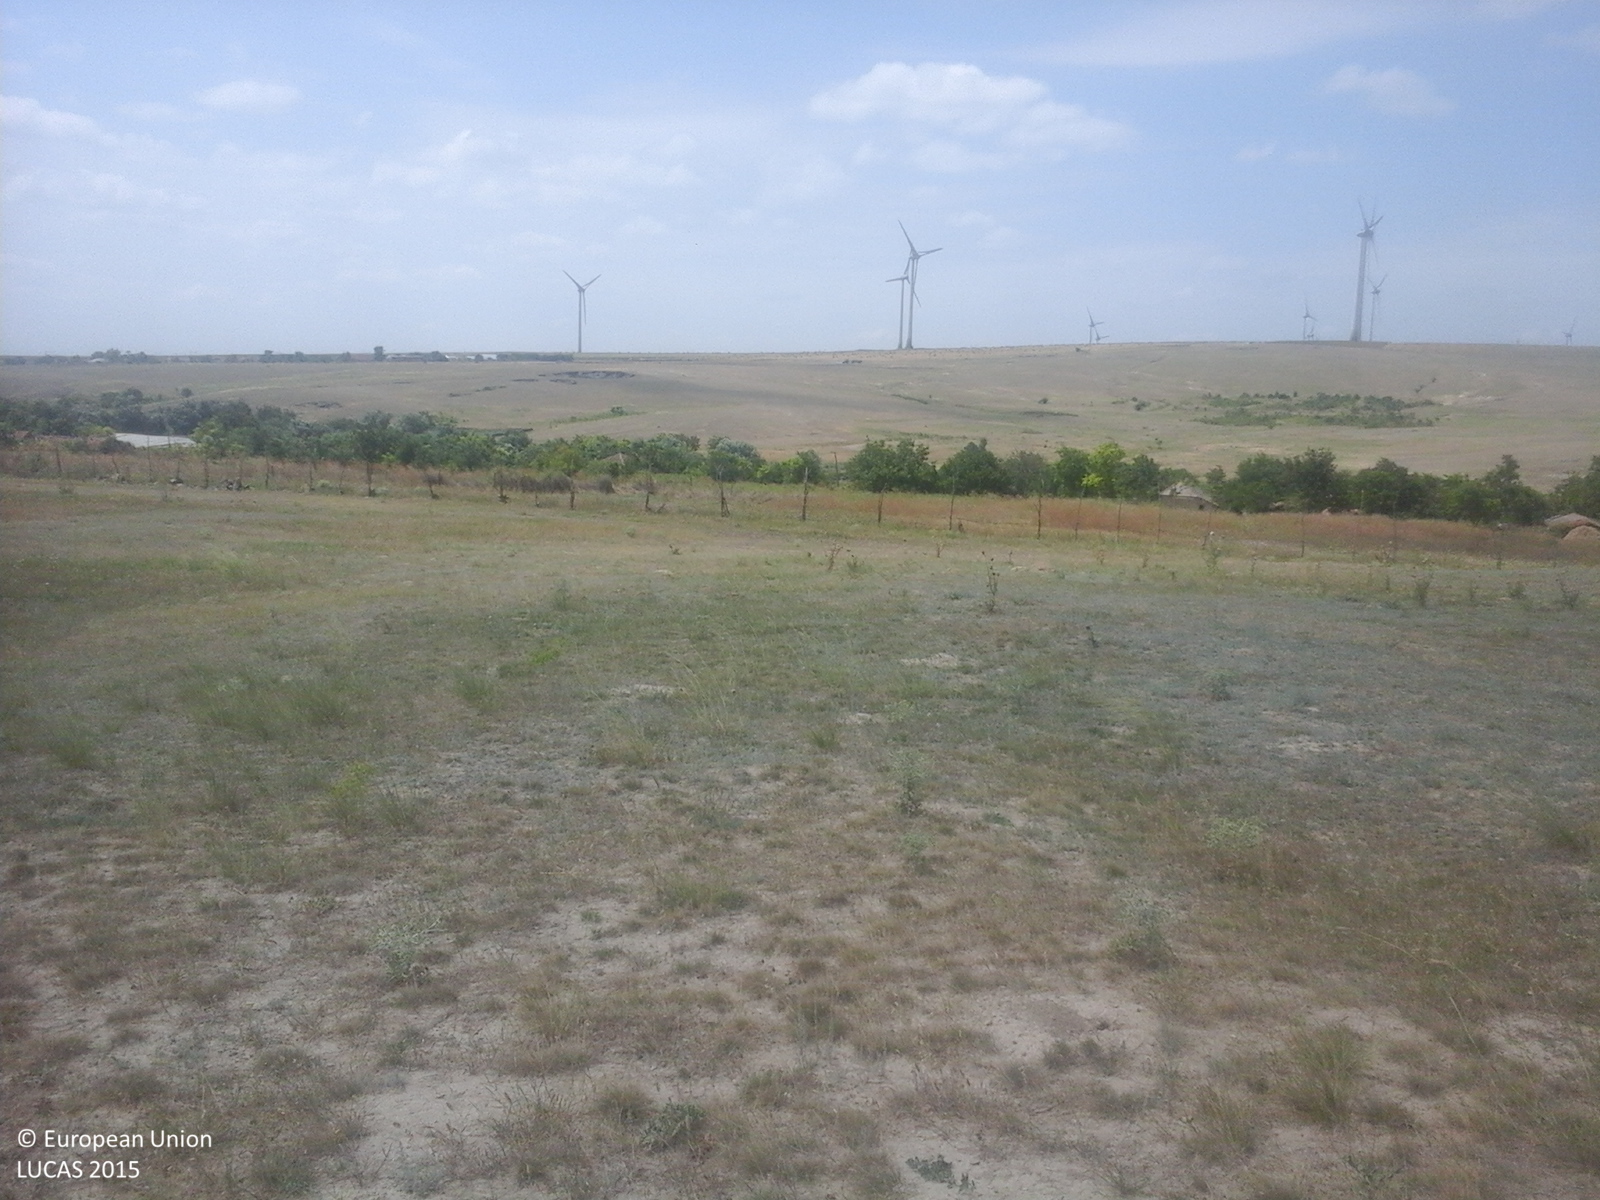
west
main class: Grassland
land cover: Grassland without tree/shrub cover
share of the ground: 50 - 75 %
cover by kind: herbaceous plants 100 %
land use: Agriculture (excluding fallow land and kitchen gardens)
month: August
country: RO
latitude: 44.7770
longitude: 28.2786
